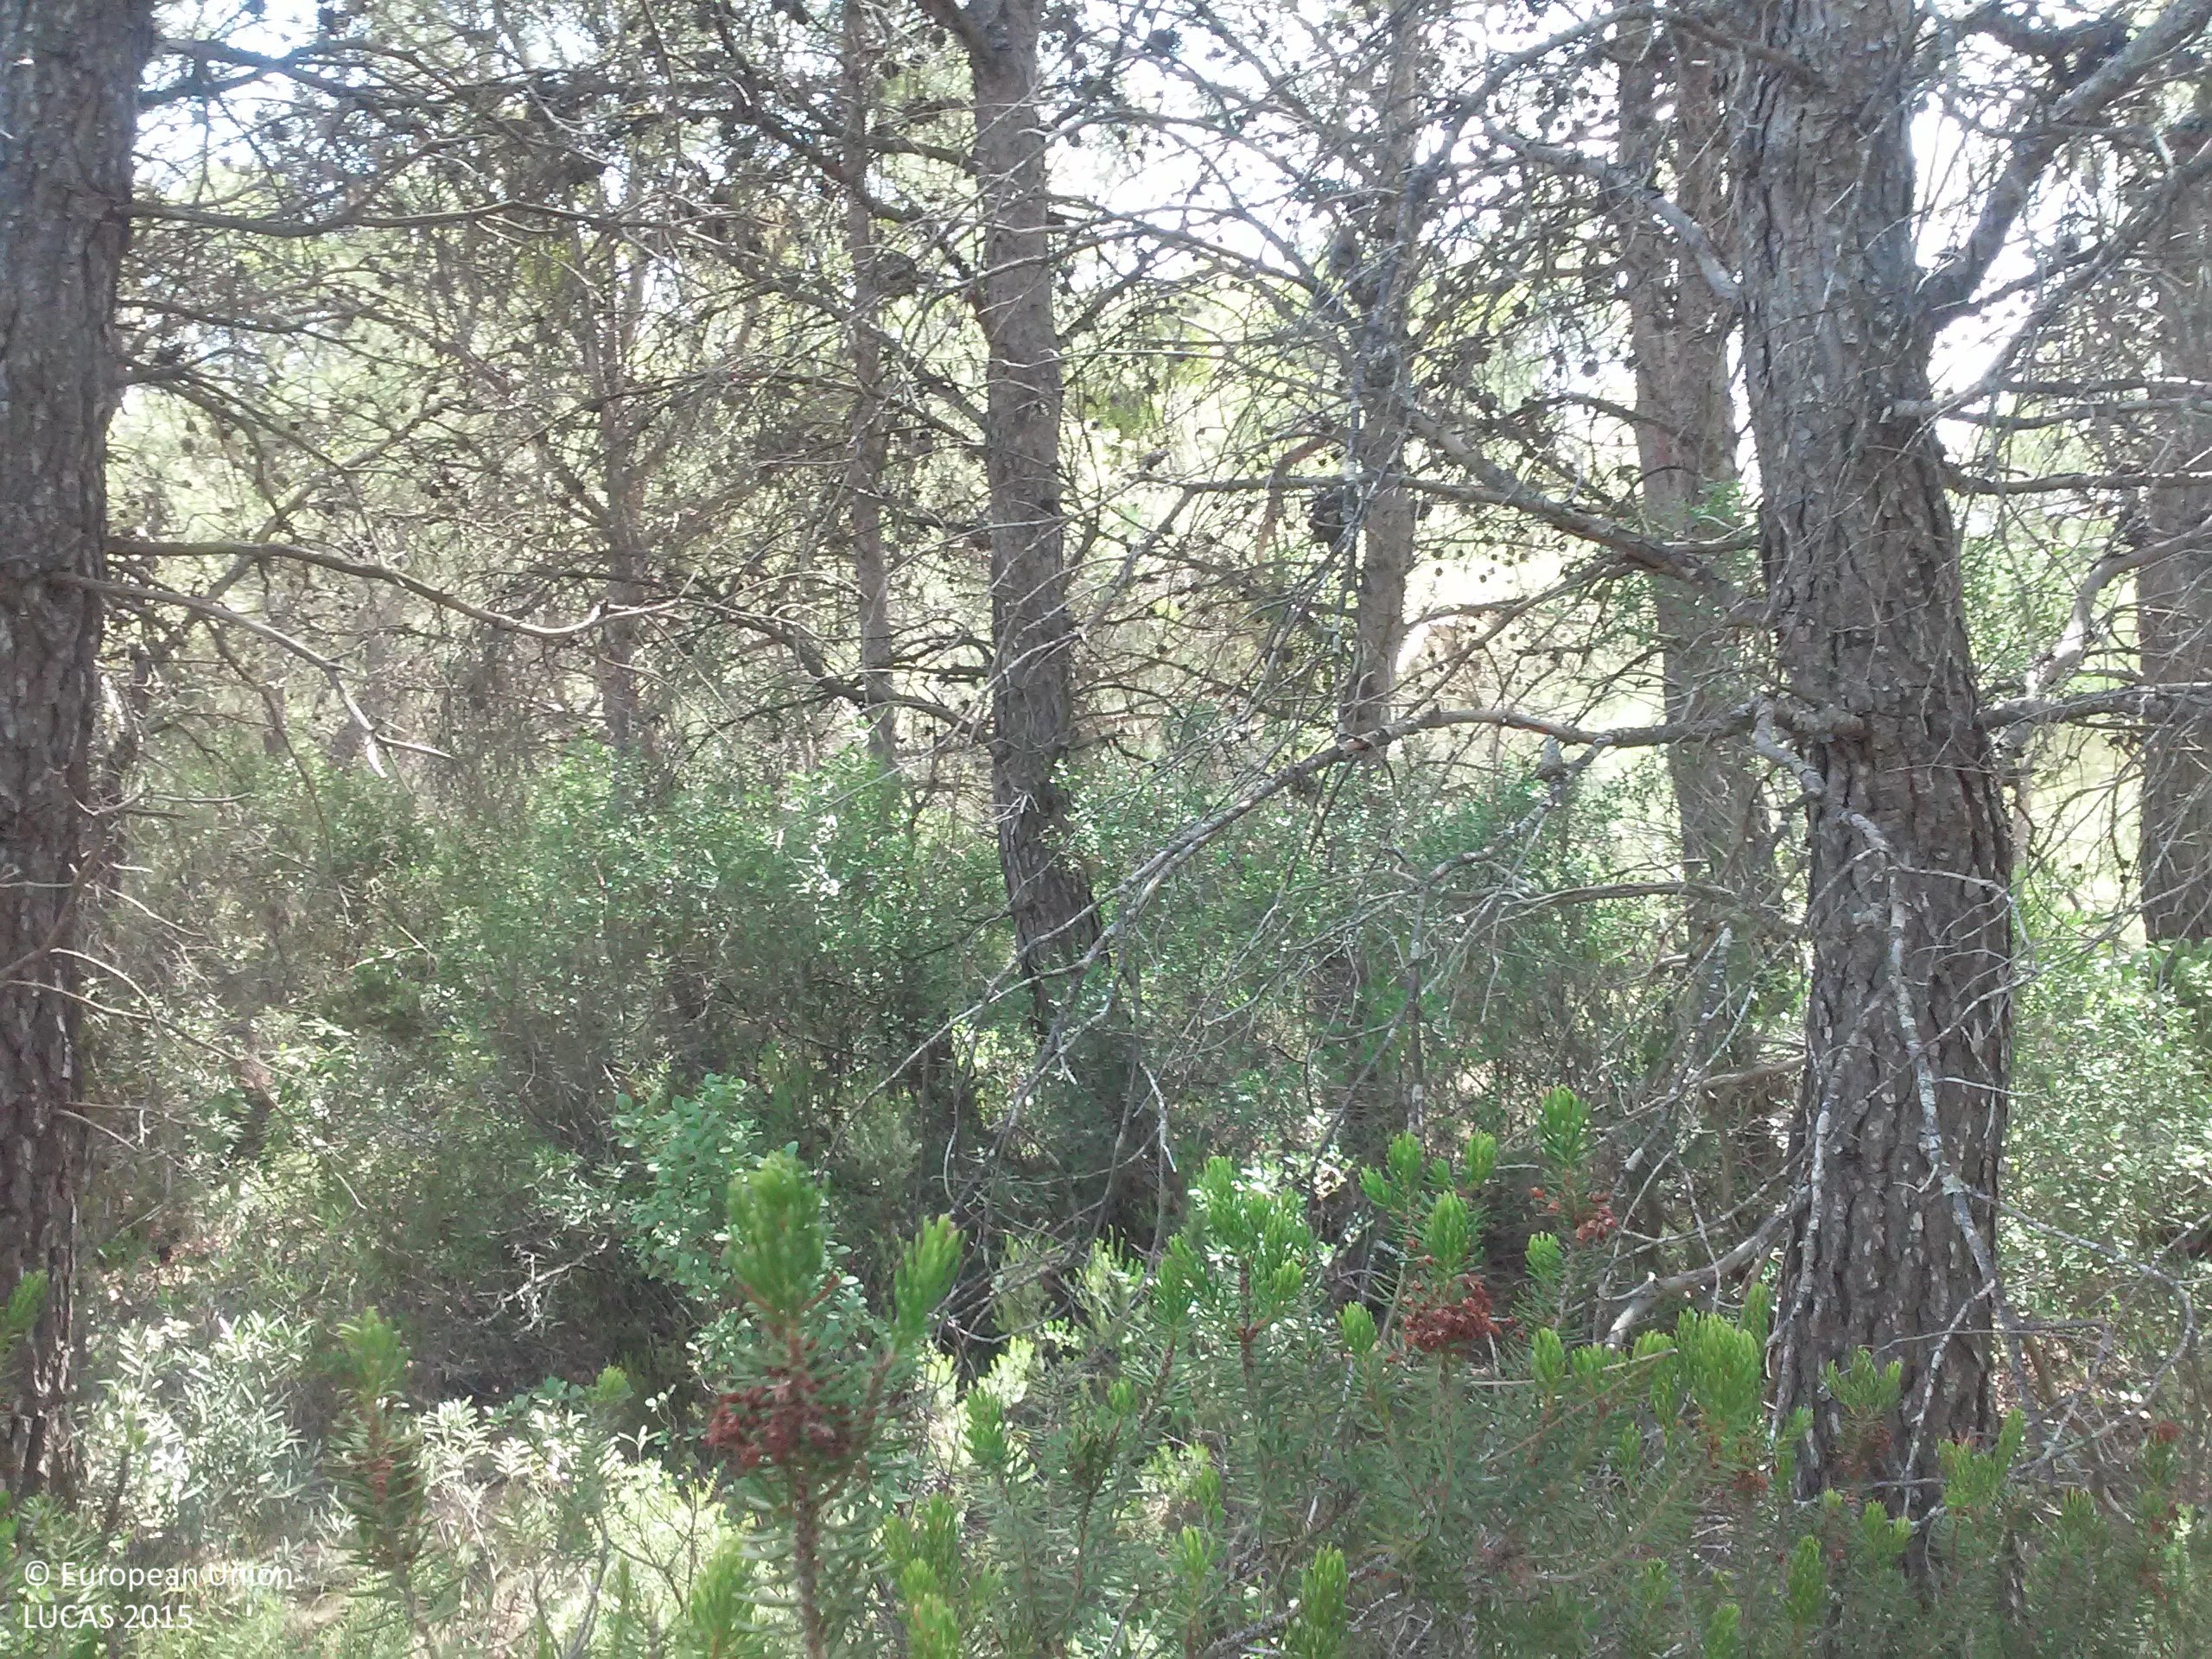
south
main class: Woodland
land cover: Pine dominated coniferous woodland
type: coniferous forest of the mediterranean region
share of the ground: 25 - 50 %
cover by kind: coniferous forest trees 40 %, shrubs 30 %, herbaceous plants 20 %, lichens and mosses 10 %
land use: Semi-natural and natural areas not in use
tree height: > 5 m
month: August
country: ES
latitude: 41.1358
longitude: 0.5203
